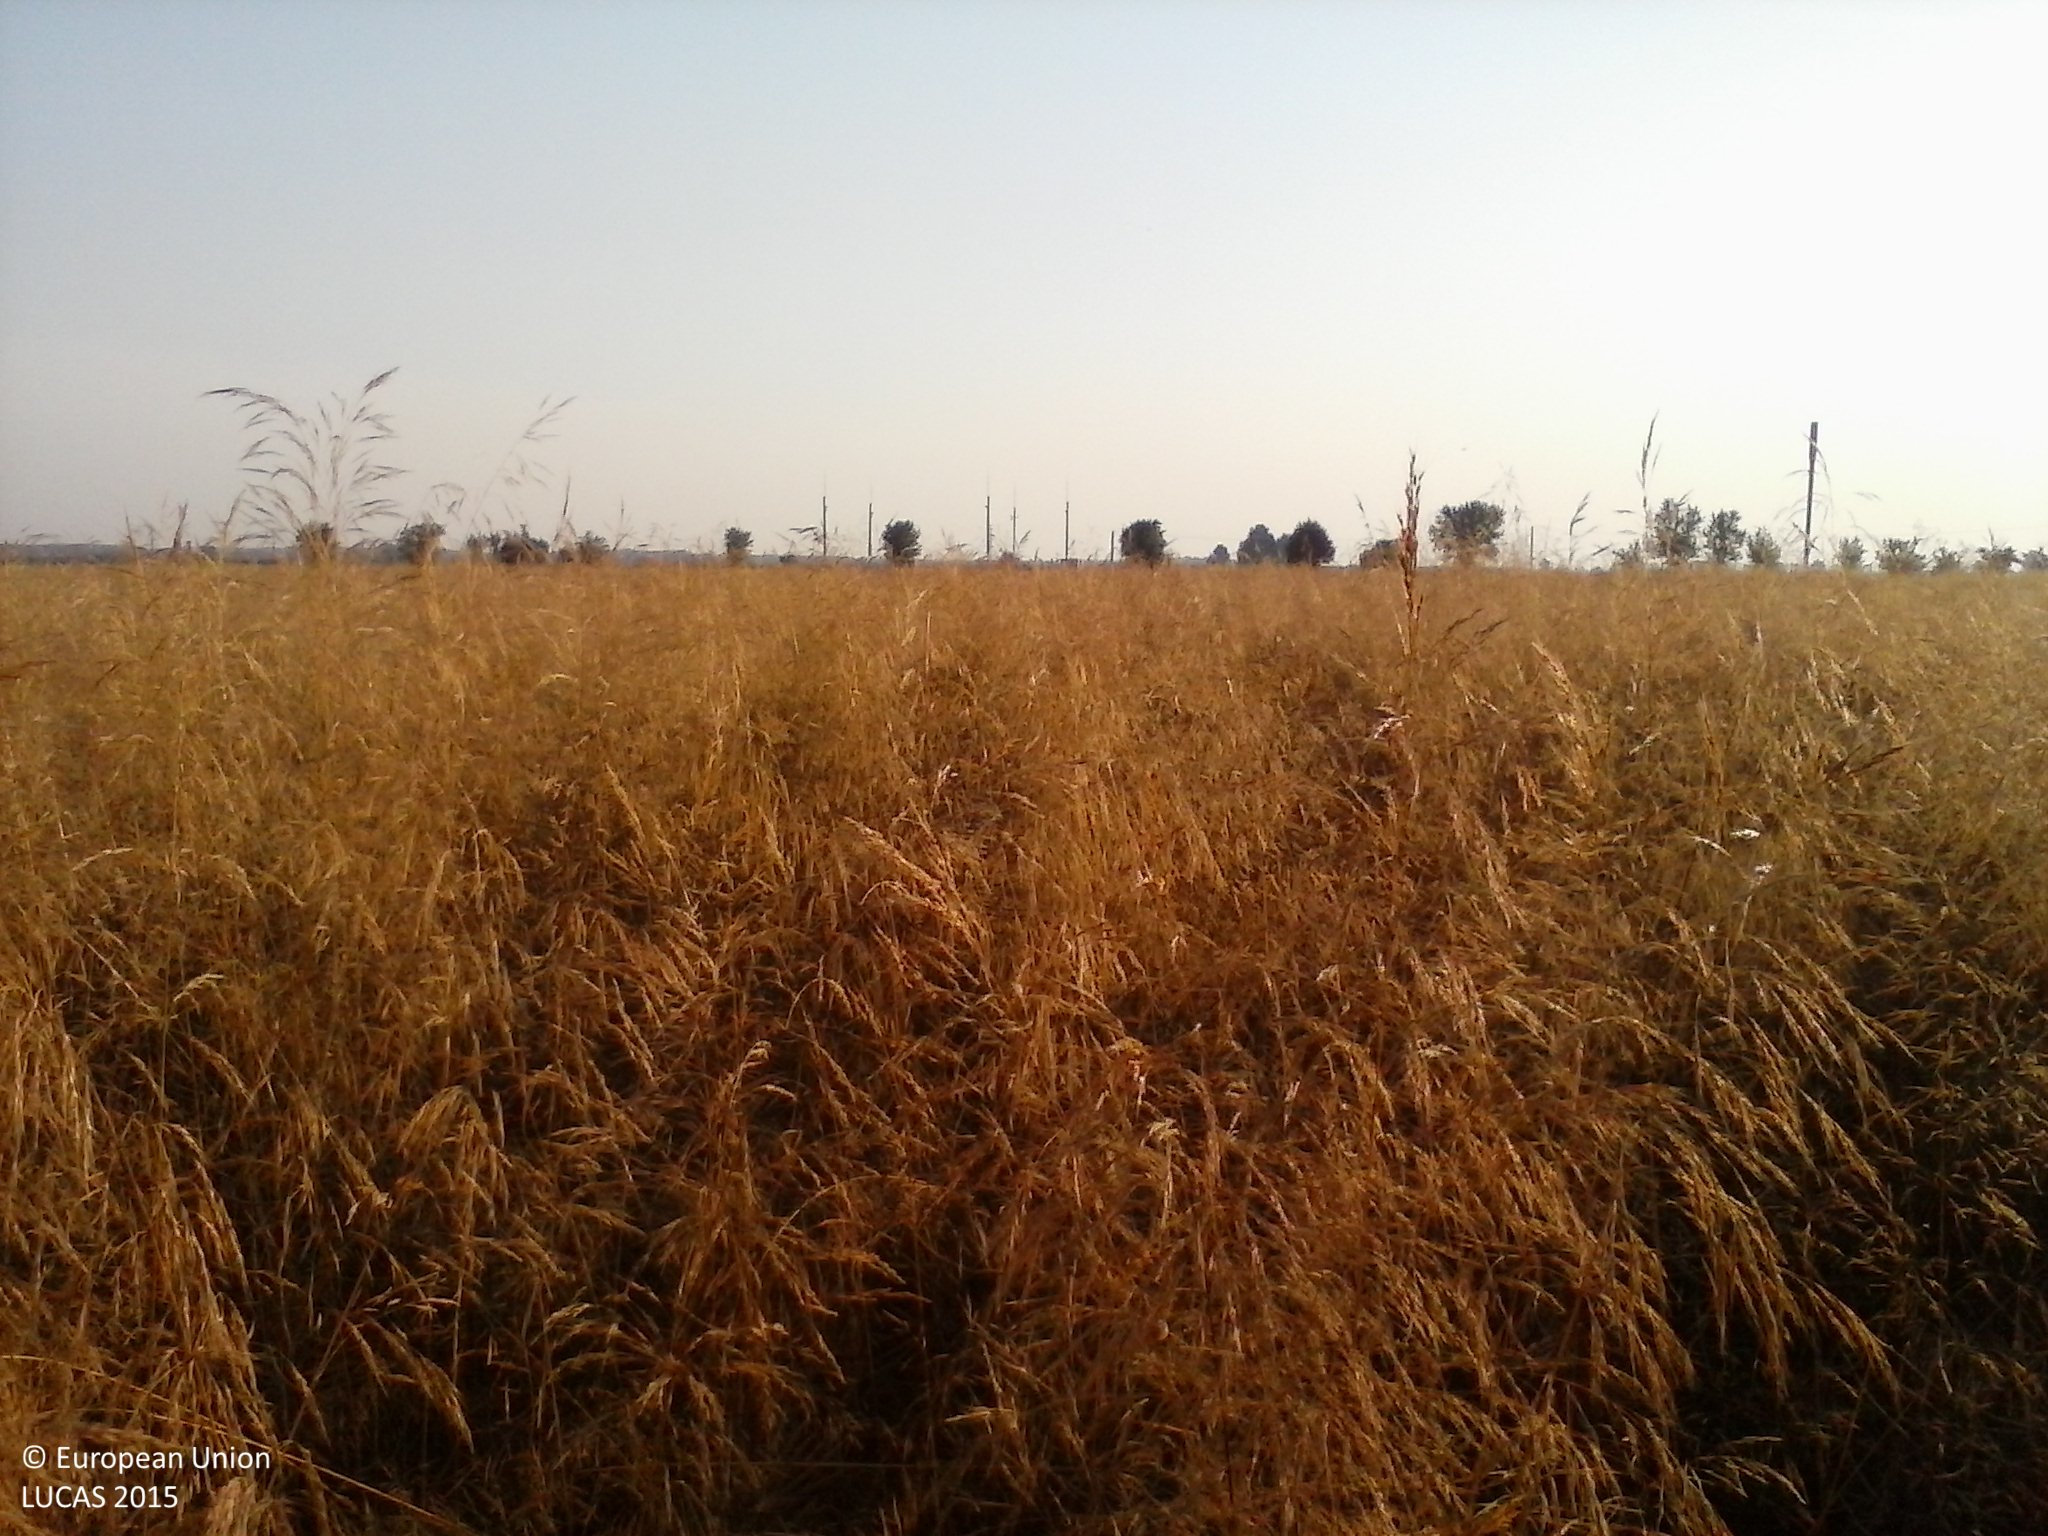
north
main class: Cropland
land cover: Rape and turnip rape
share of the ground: 10 - 25 %
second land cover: Spontaneously vegetated surfaces
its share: > 75 %
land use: Agriculture (excluding fallow land and kitchen gardens)
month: July
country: HU
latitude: 46.4324
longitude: 19.5307
